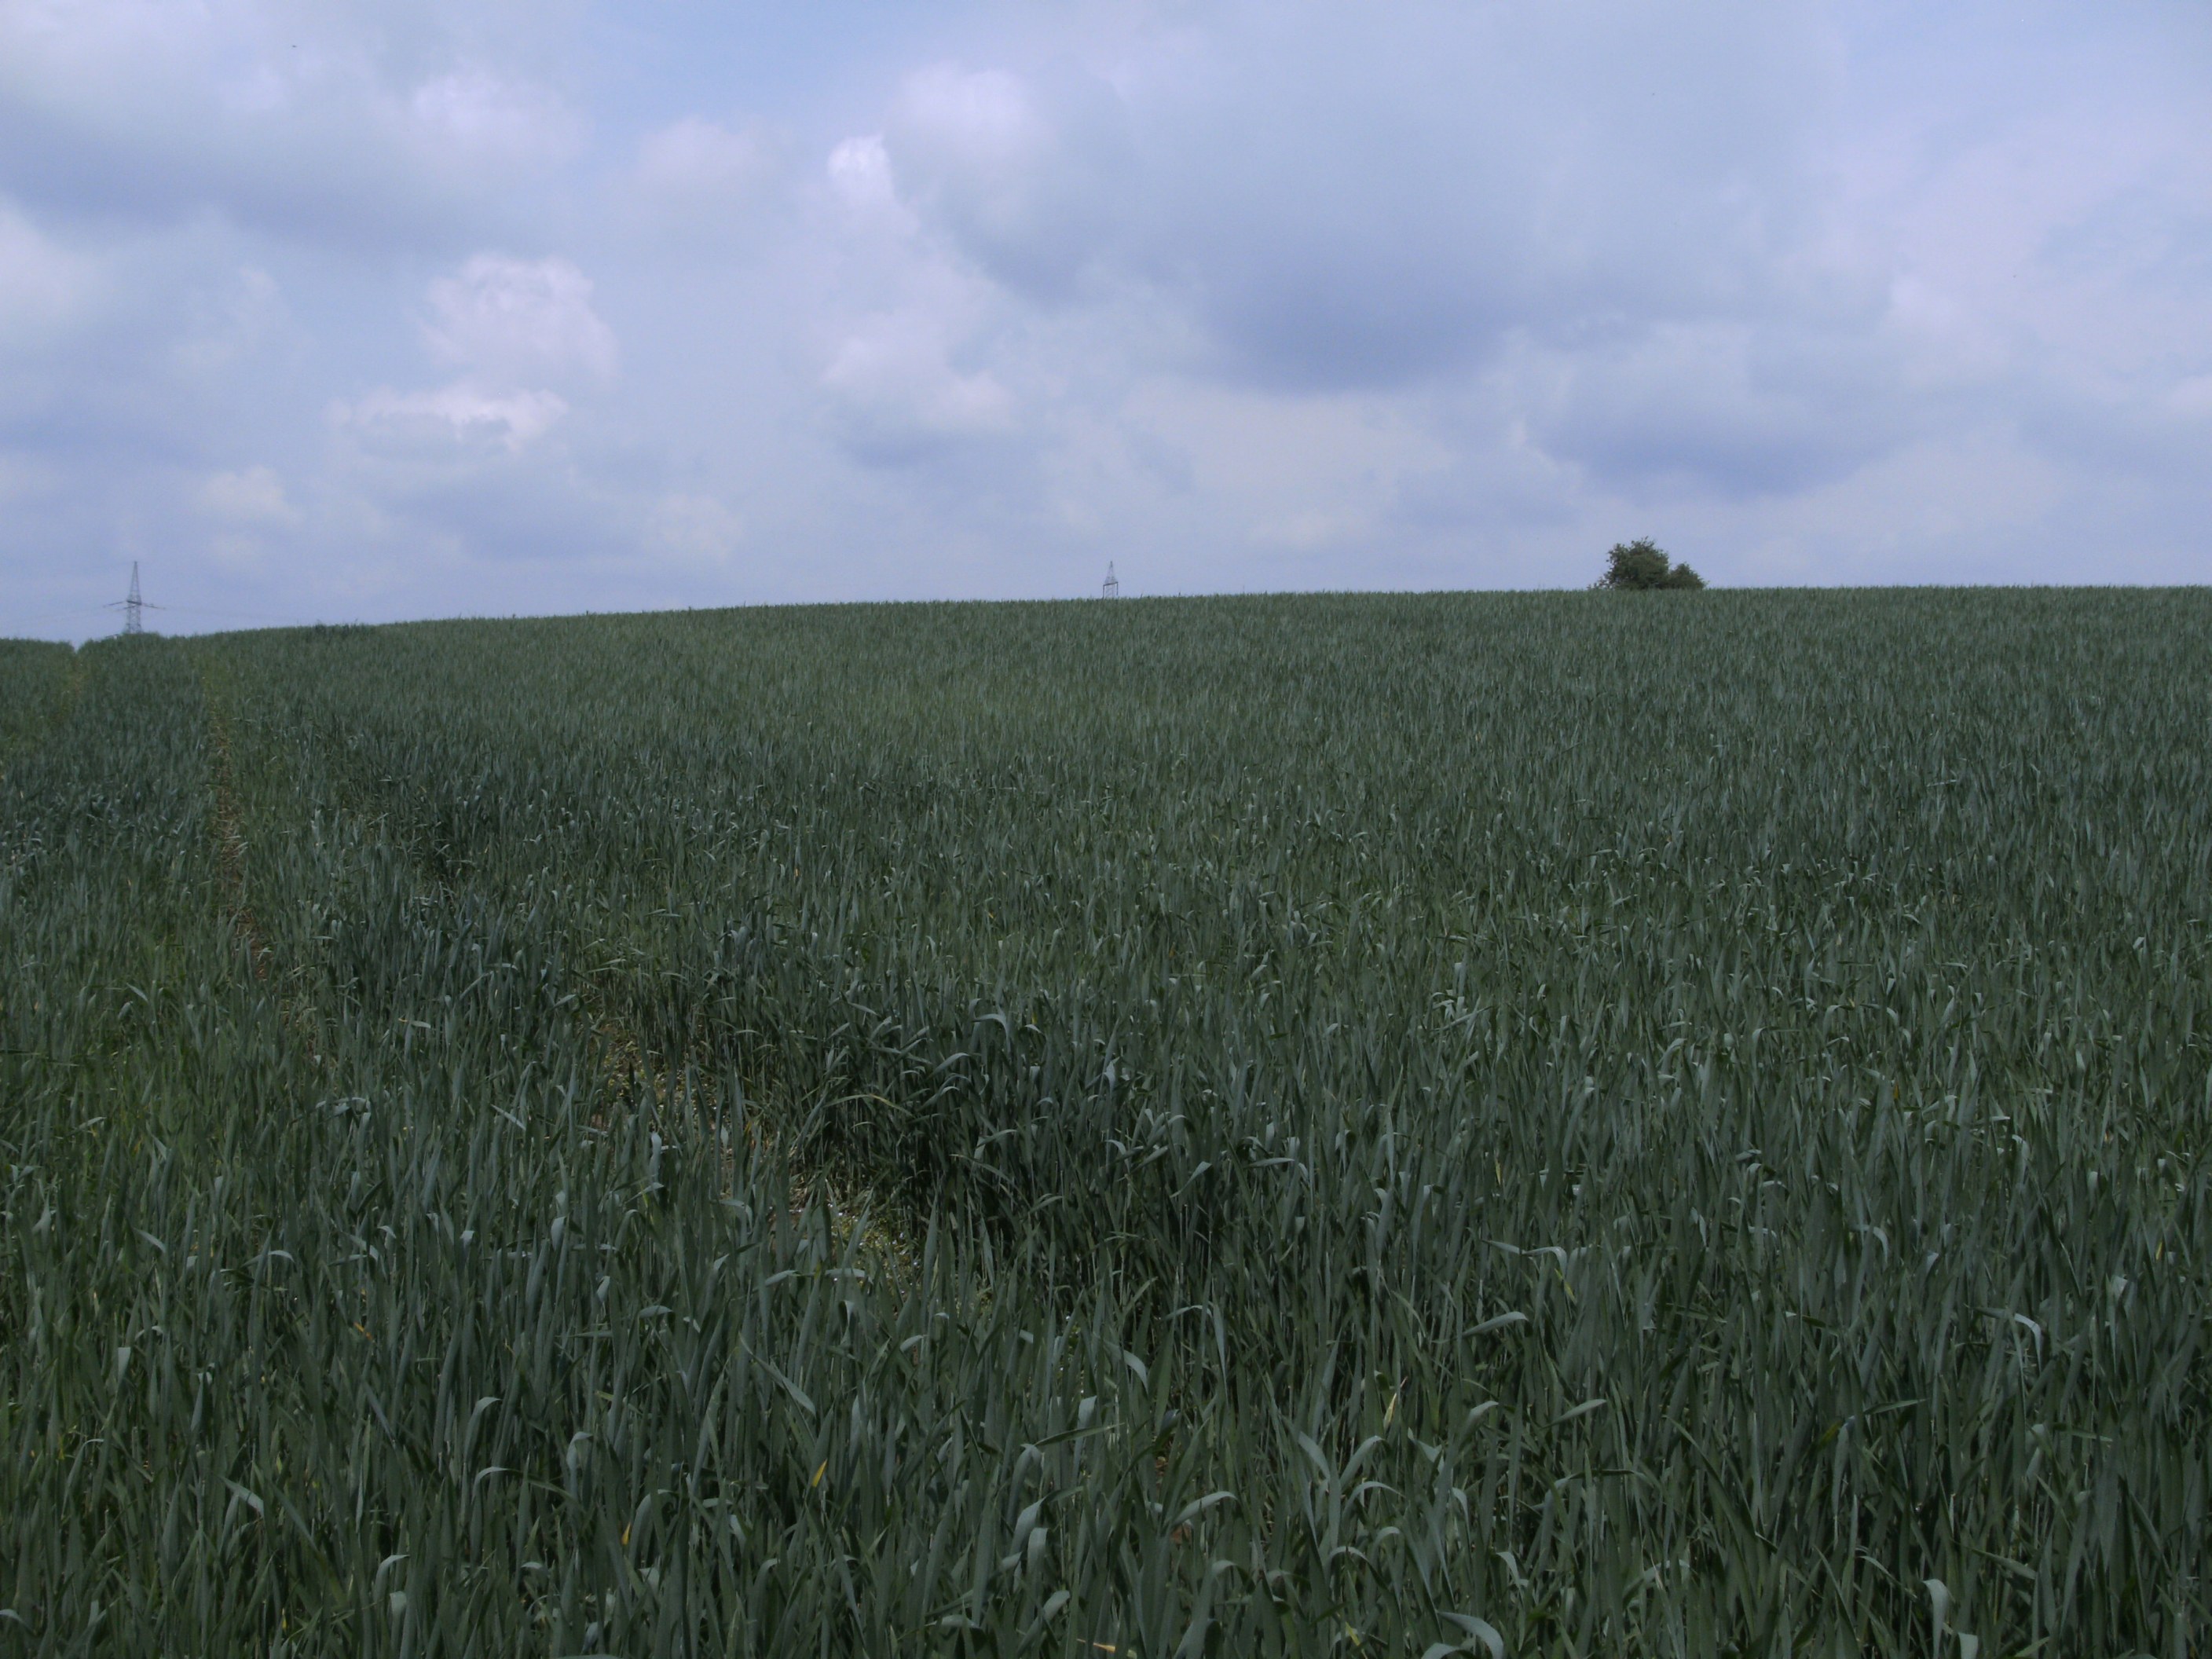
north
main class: Cropland
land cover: Common wheat
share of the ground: > 75 %
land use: Agriculture (excluding fallow land and kitchen gardens)
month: May
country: AT
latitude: 48.0775
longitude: 14.0398
